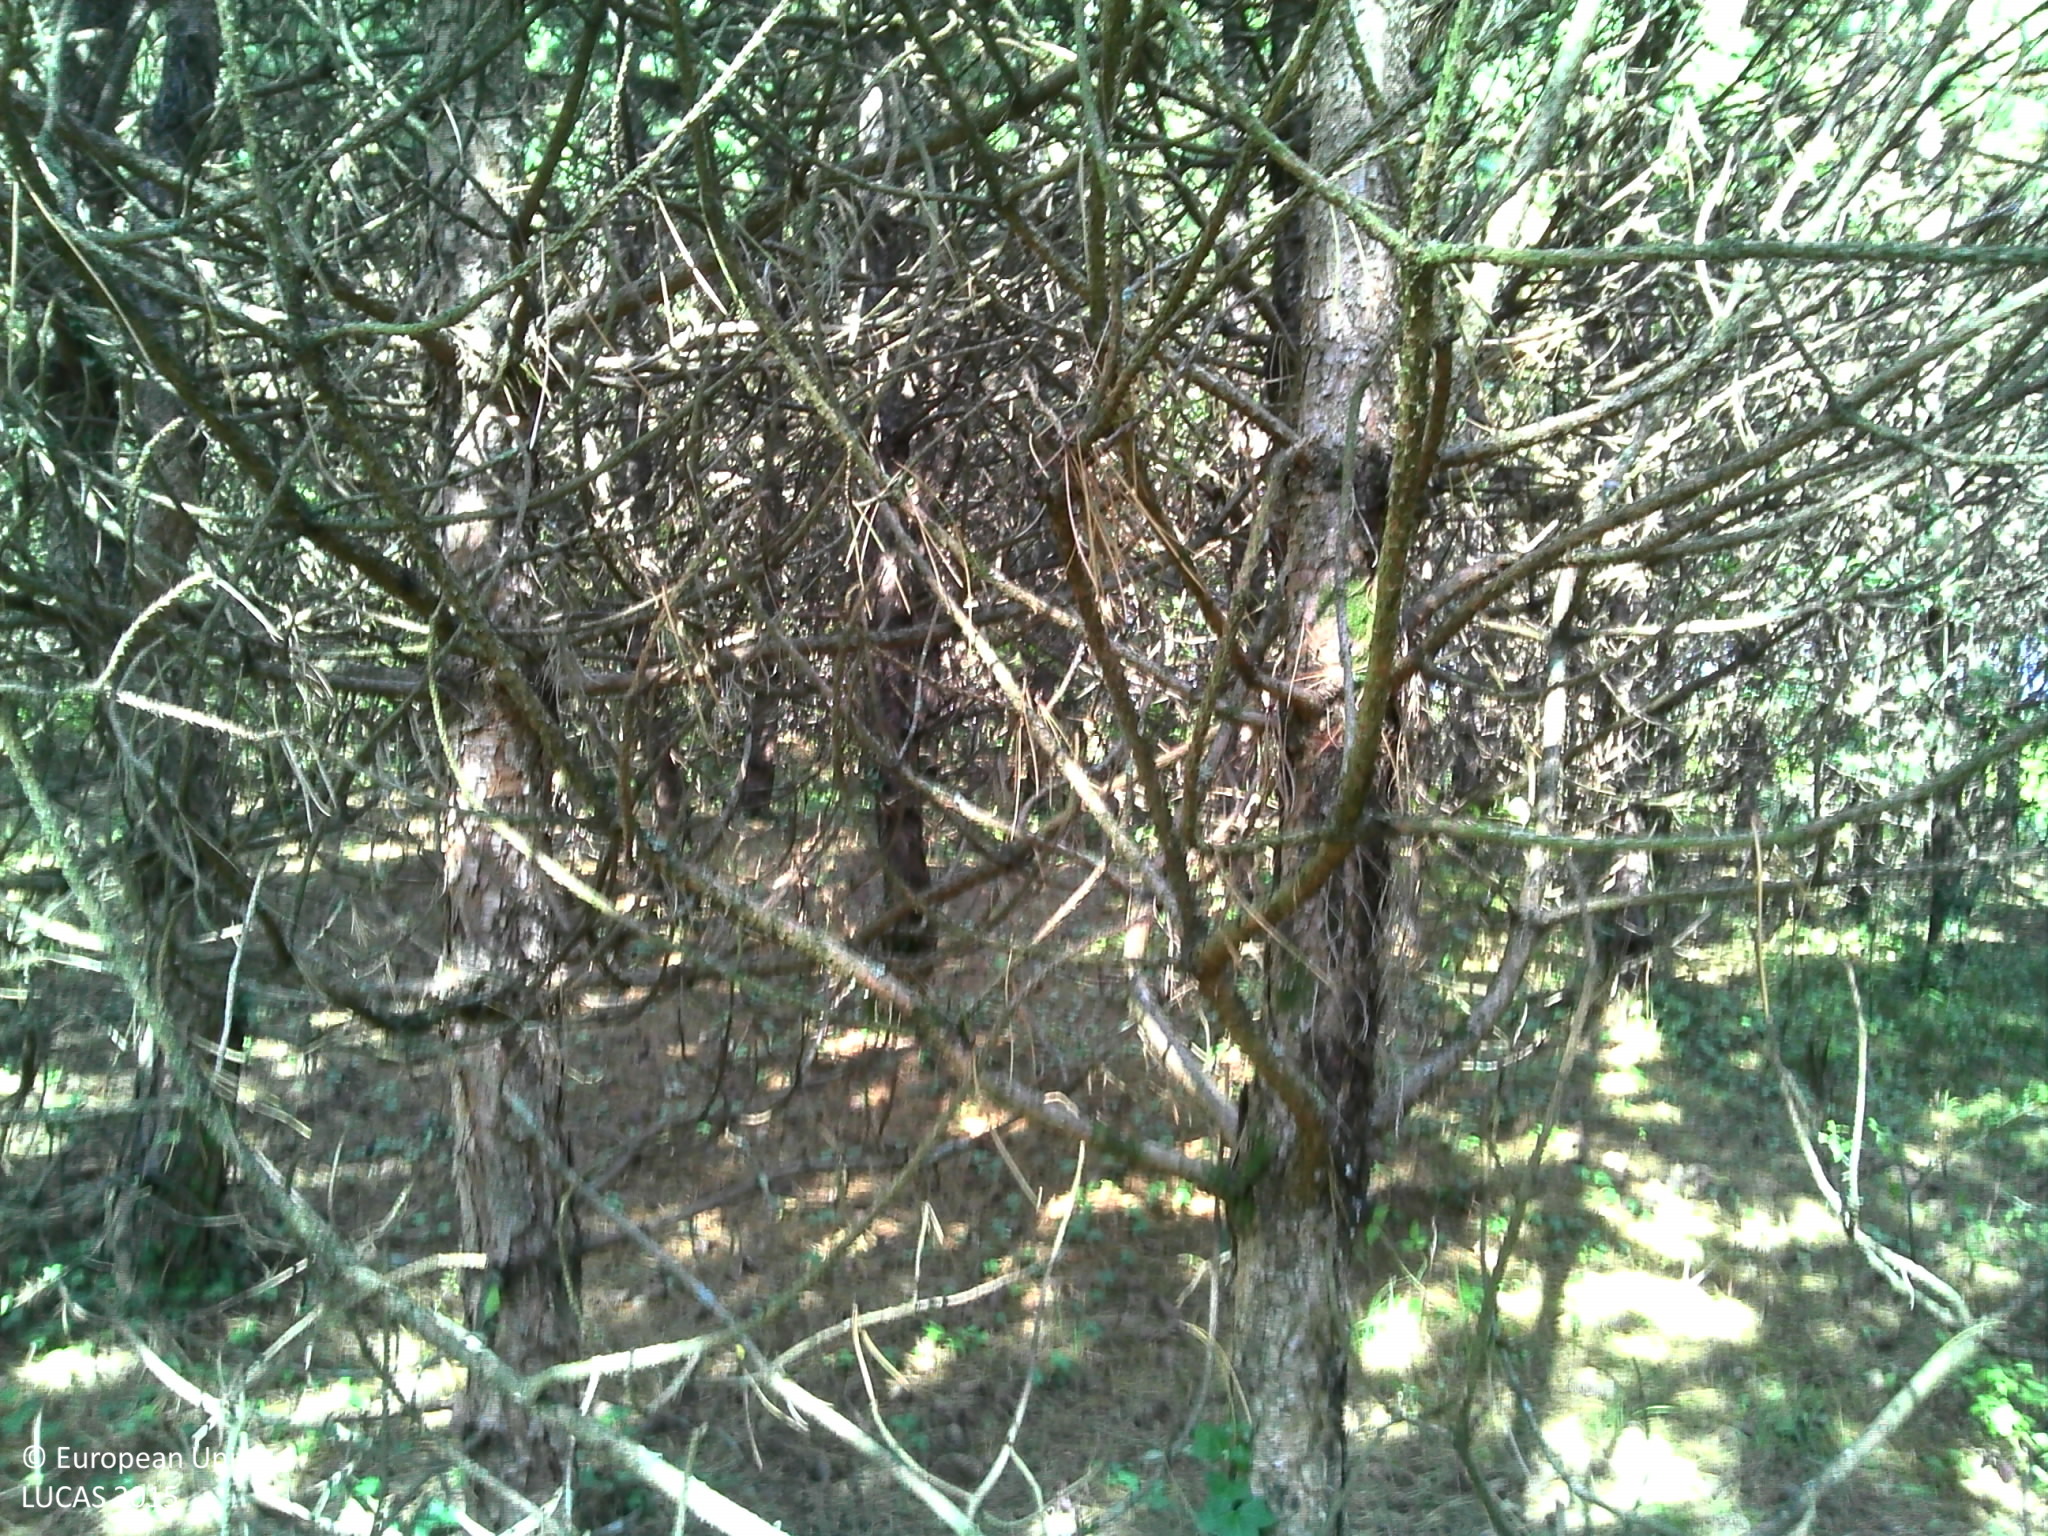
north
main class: Woodland
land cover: Pine dominated coniferous woodland
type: exotic forest
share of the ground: > 75 %
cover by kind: coniferous forest trees 100 %
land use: Forestry
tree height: > 5 m
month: September
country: FR
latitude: 48.3240
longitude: 4.2107
